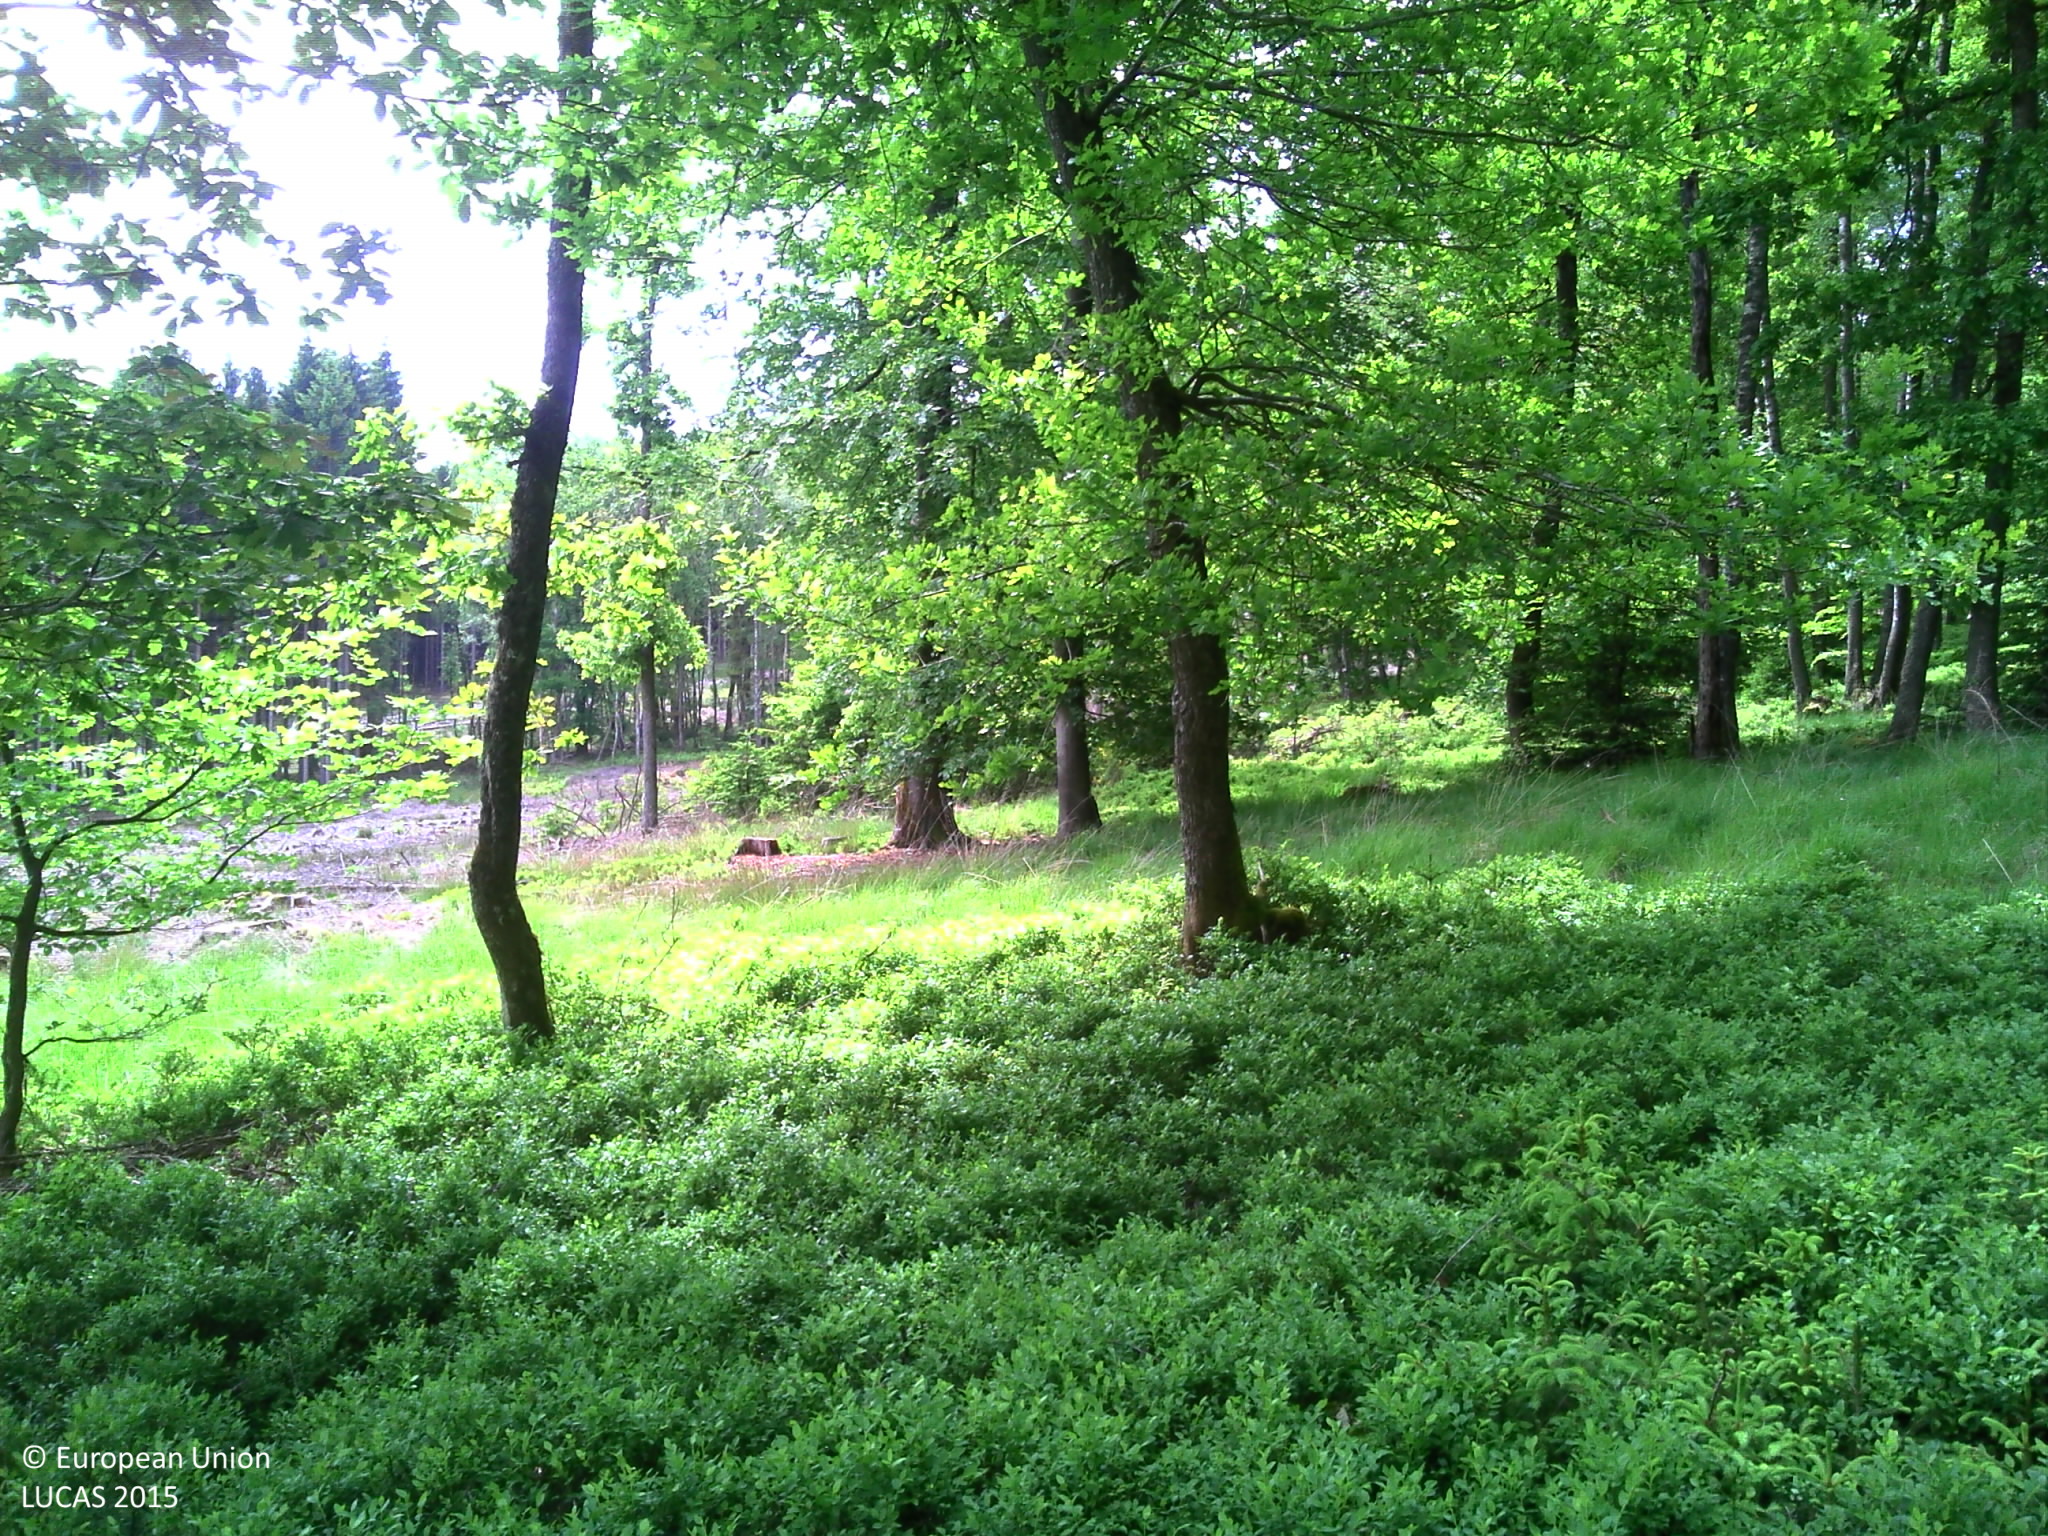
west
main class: Shrubland
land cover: Shrubland without tree cover
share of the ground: > 75 %
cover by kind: herbaceous plants 45 %, shrubs 25 %, unconsolidated bare surface 15 %
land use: Forestry
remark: Clear cut
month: June
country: BE
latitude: 50.3578
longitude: 5.7678
